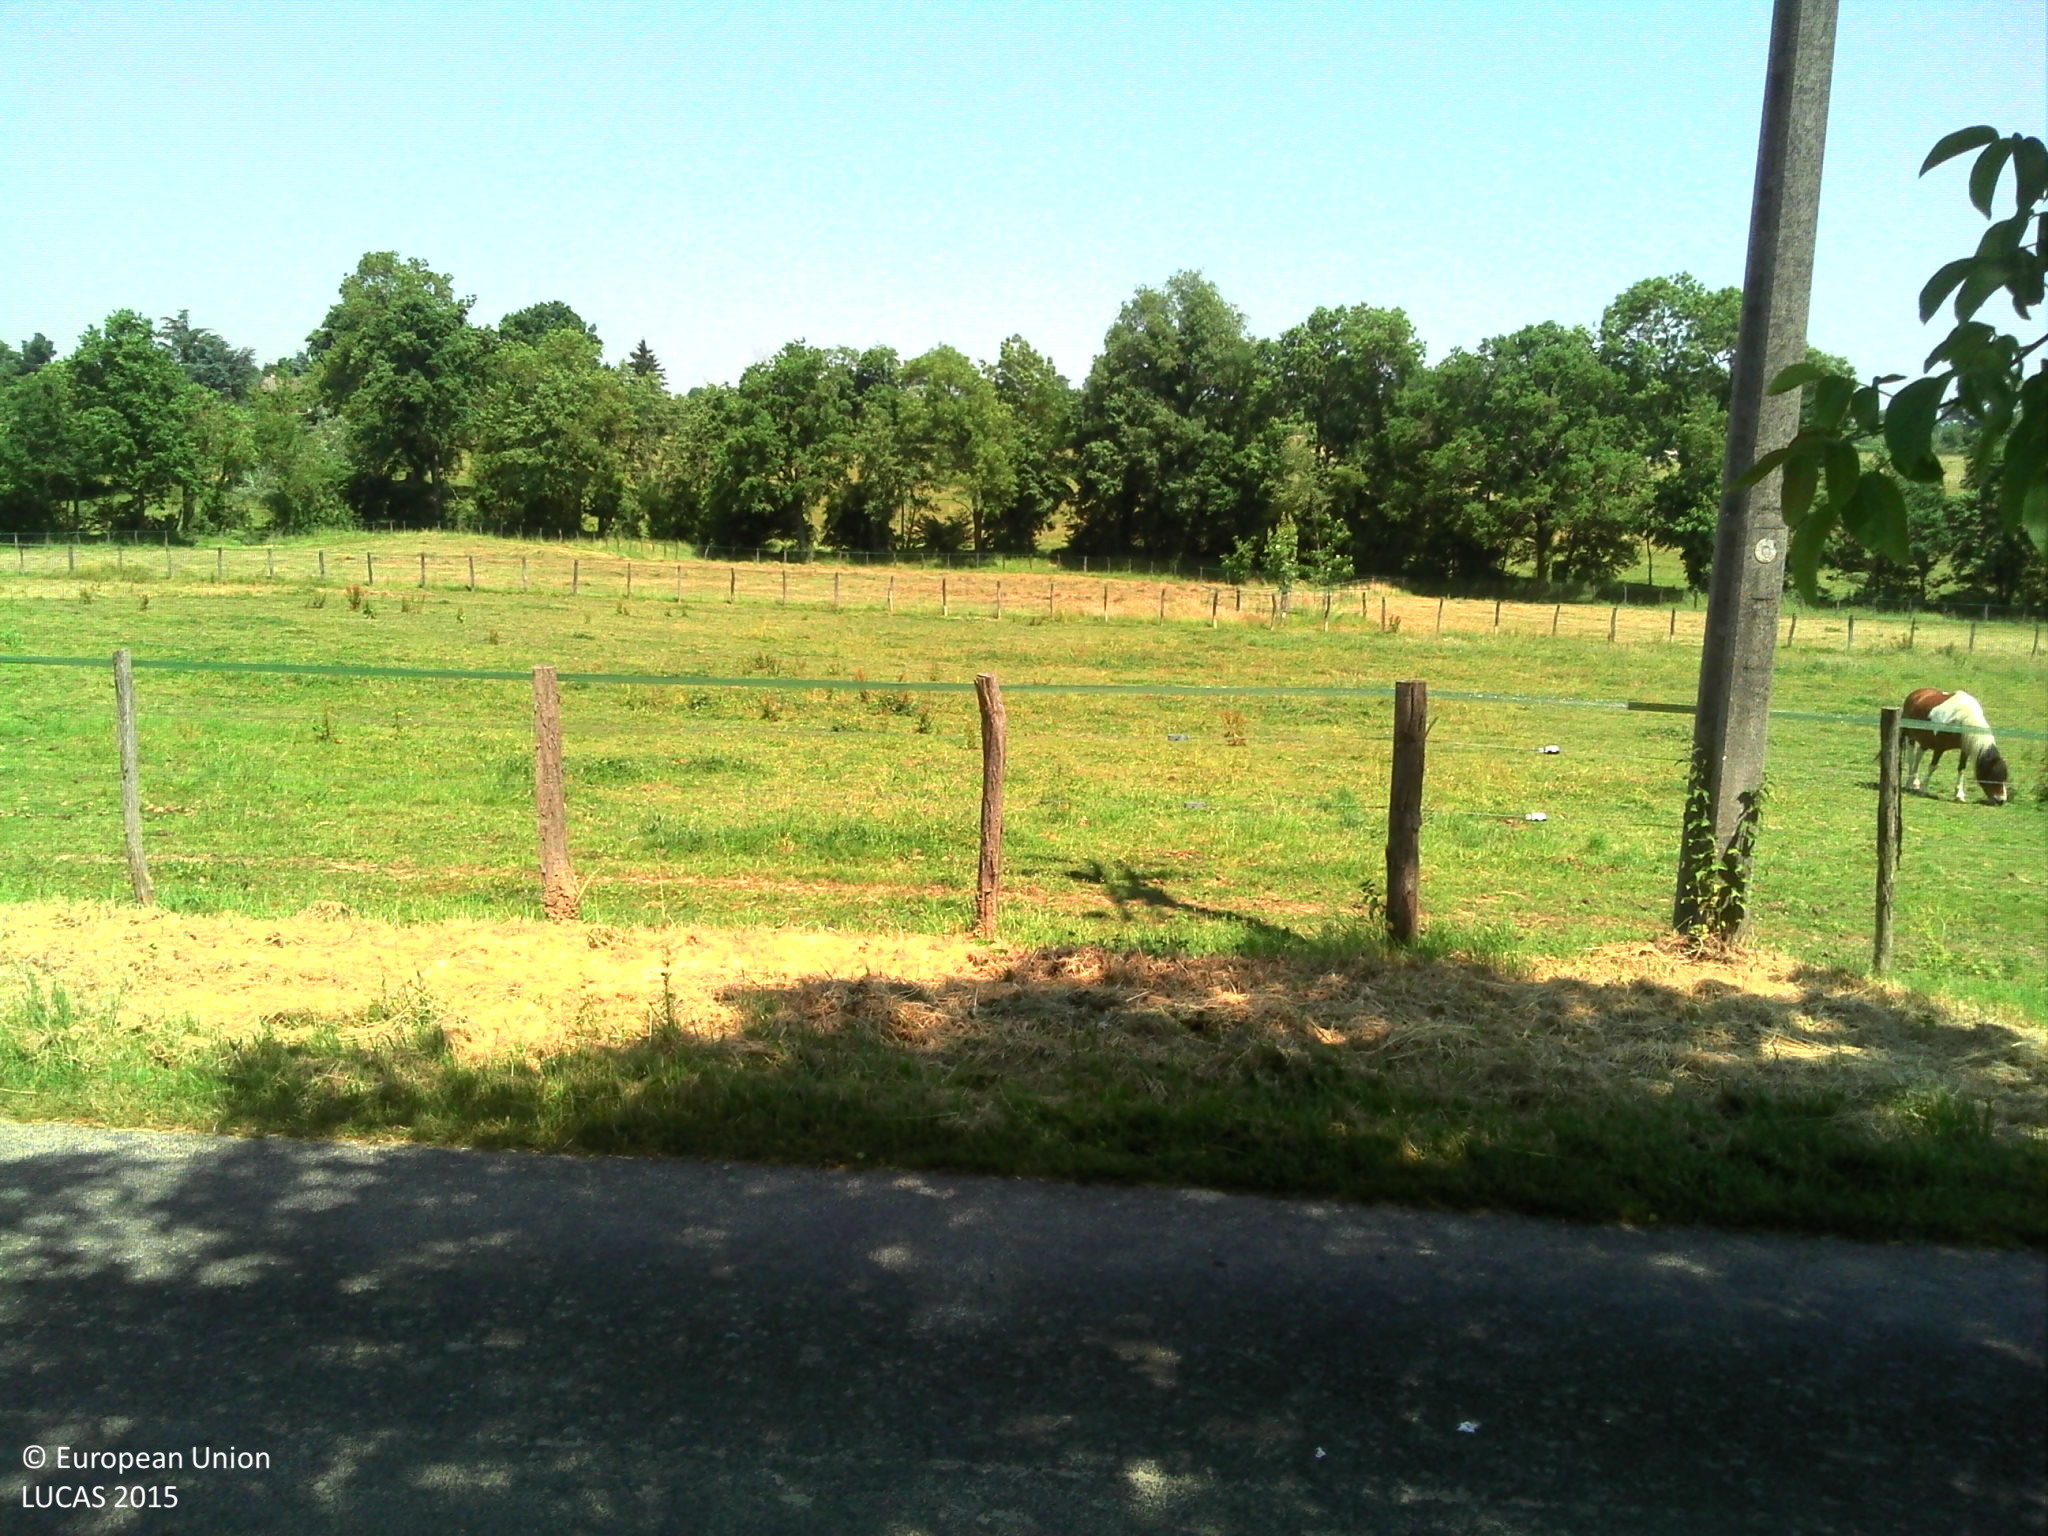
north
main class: Cropland
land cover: Durum wheat
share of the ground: > 75 %
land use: Agriculture (excluding fallow land and kitchen gardens)
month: June
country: FR
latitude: 45.9926
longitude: 4.8517
